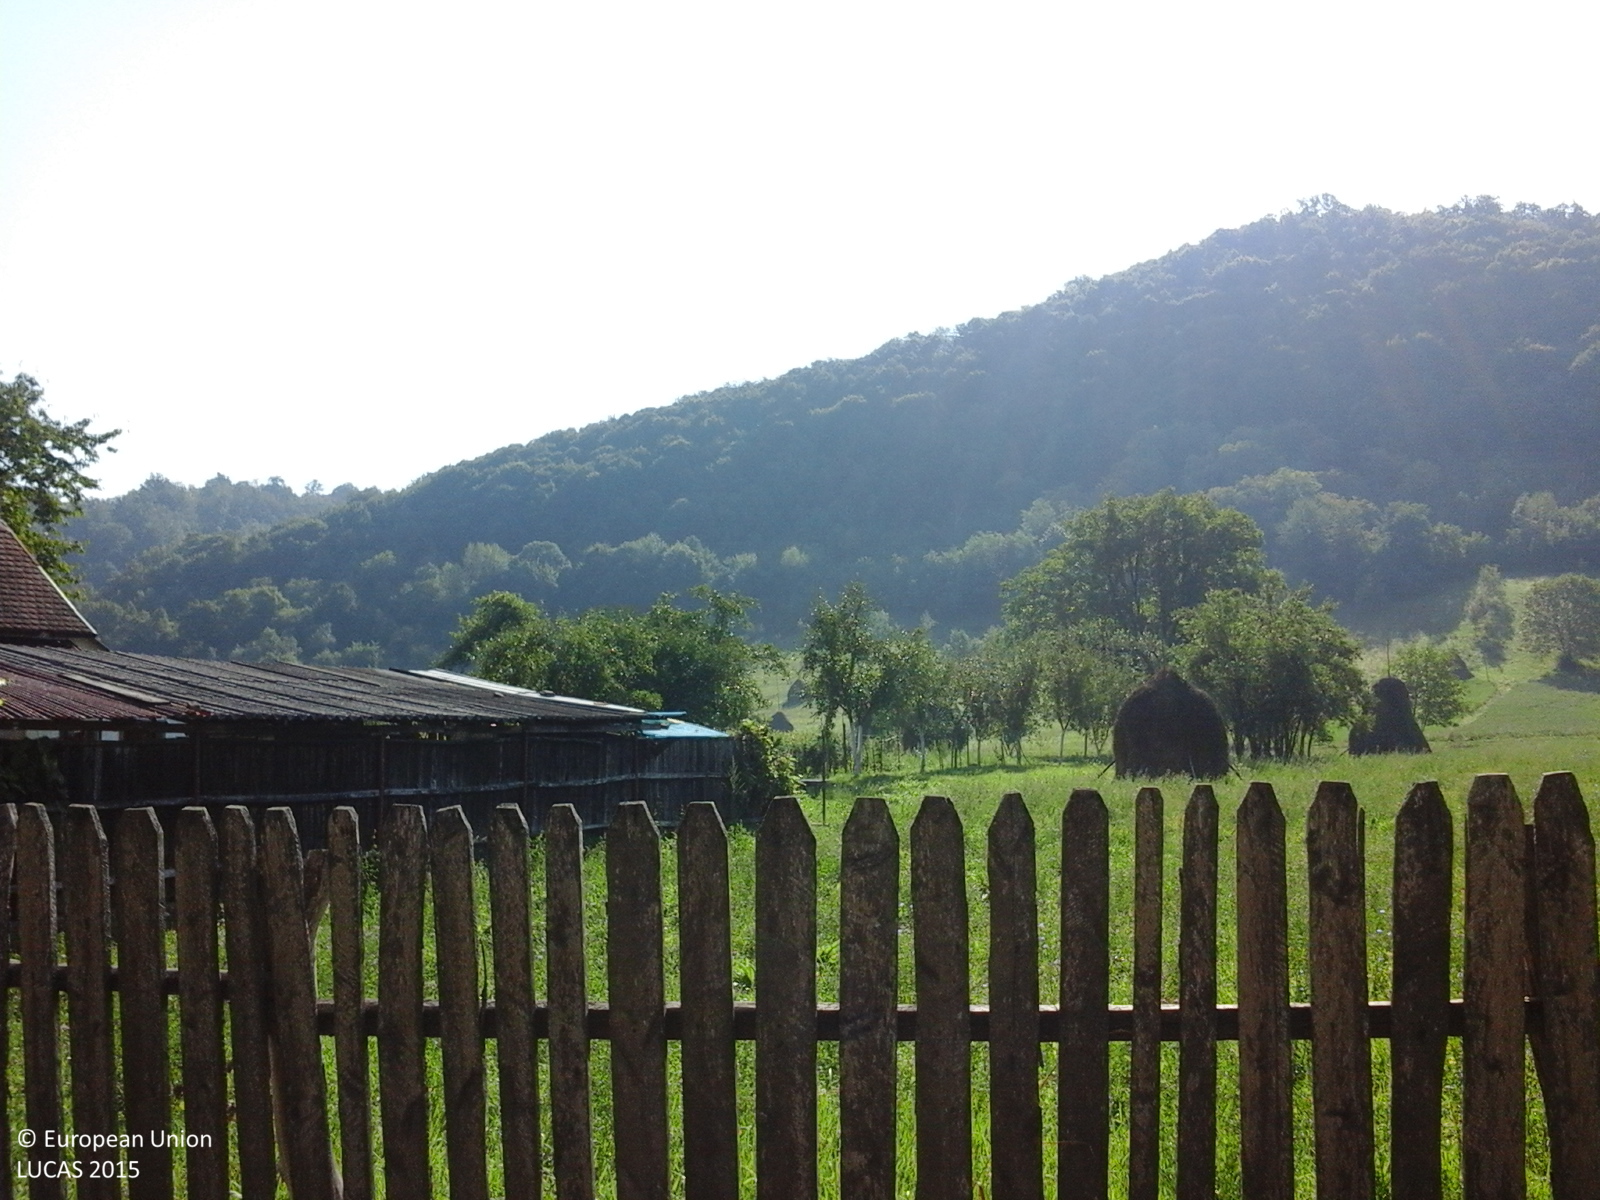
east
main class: Cropland
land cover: Other fruit trees and berries
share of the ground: 25 - 50 %
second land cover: Grassland without tree/shrub cover
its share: > 75 %
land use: Agriculture (excluding fallow land and kitchen gardens)
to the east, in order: Other fruit trees and berries; Grassland without tree/shrub cover; Single bushes/trees; Grass margins; Tracks; Grass margins; Grassland without tree/shrub cover; Other fruit trees and berries; Broadleaved woodland
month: August
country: RO
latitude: 46.2182
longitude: 22.3237
